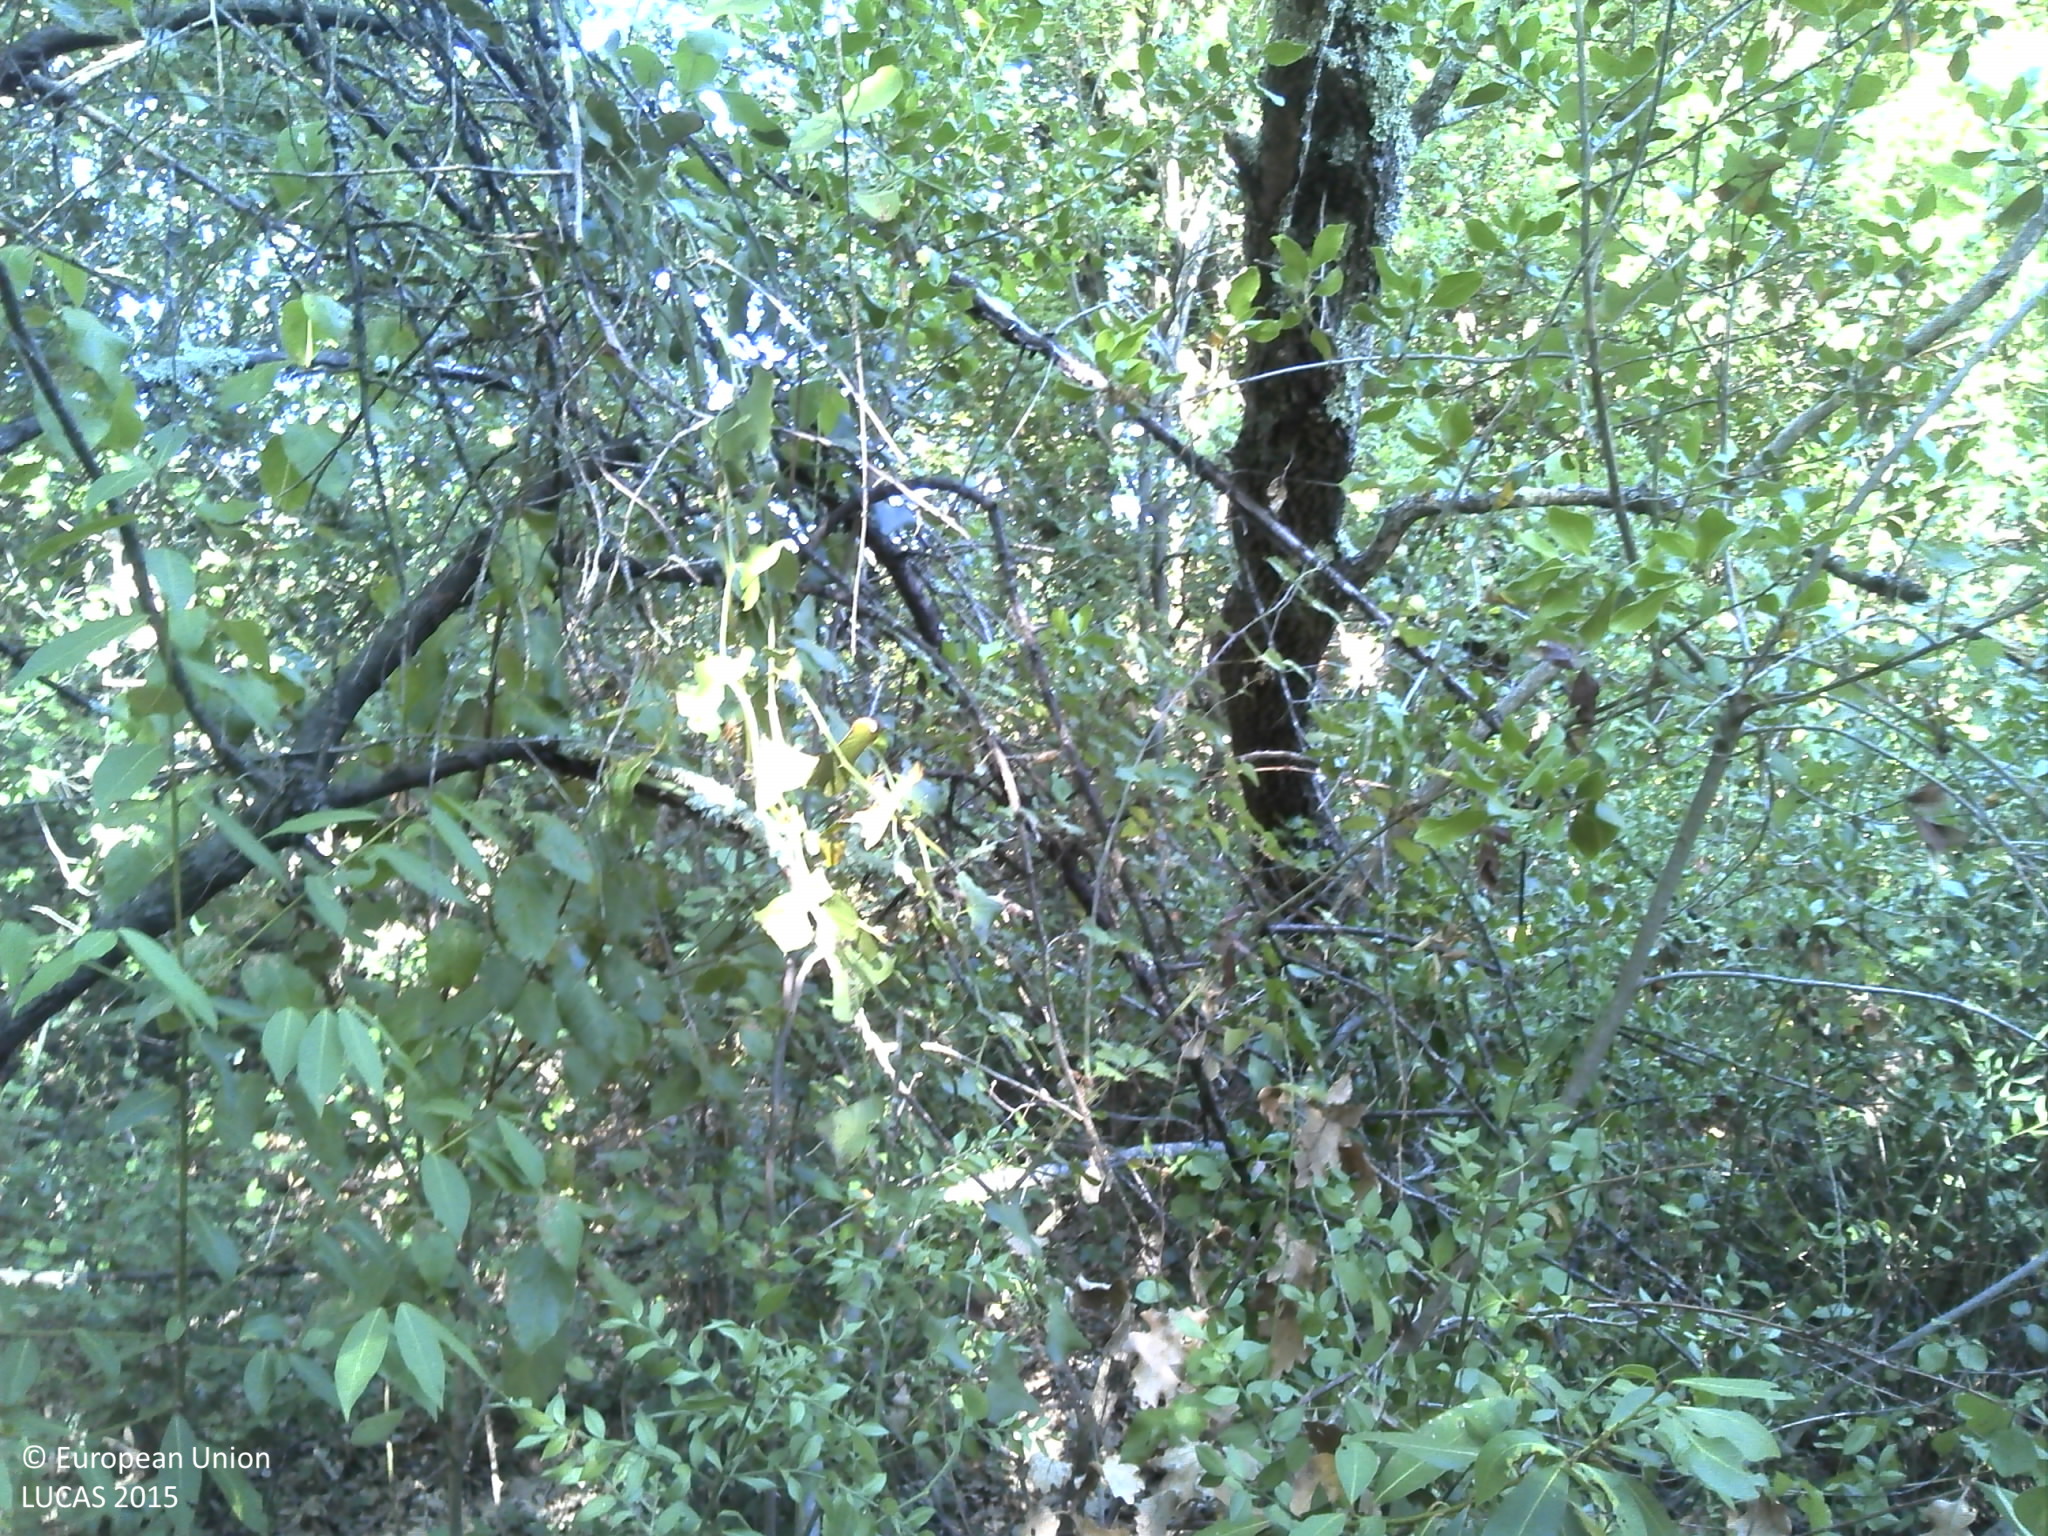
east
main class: Woodland
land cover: Broadleaved woodland
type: acidophilous oak and oak-birch forest
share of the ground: > 75 %
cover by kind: broadleaved forest trees 80 %, herbaceous plants 10 %, unconsolidated bare surface 10 %
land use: Semi-natural and natural areas not in use
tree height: > 5 m
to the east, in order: Broadleaved woodland; Fences; Dry stone walls; Grass margins; Tracks; Grass margins; Fences; Broadleaved woodland; Shrubland with sparse tree cover; Broadleaved woodland; Fences; Abandoned hedges; Grass margins; Tracks; Grass margins; Lines of trees; Electric lines; Grass margins; Broadleaved woodland; Fences; Broadleaved woodland; Fences; Broadleaved woodland; Fences
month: July
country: FR
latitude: 43.6356
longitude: 3.1534
